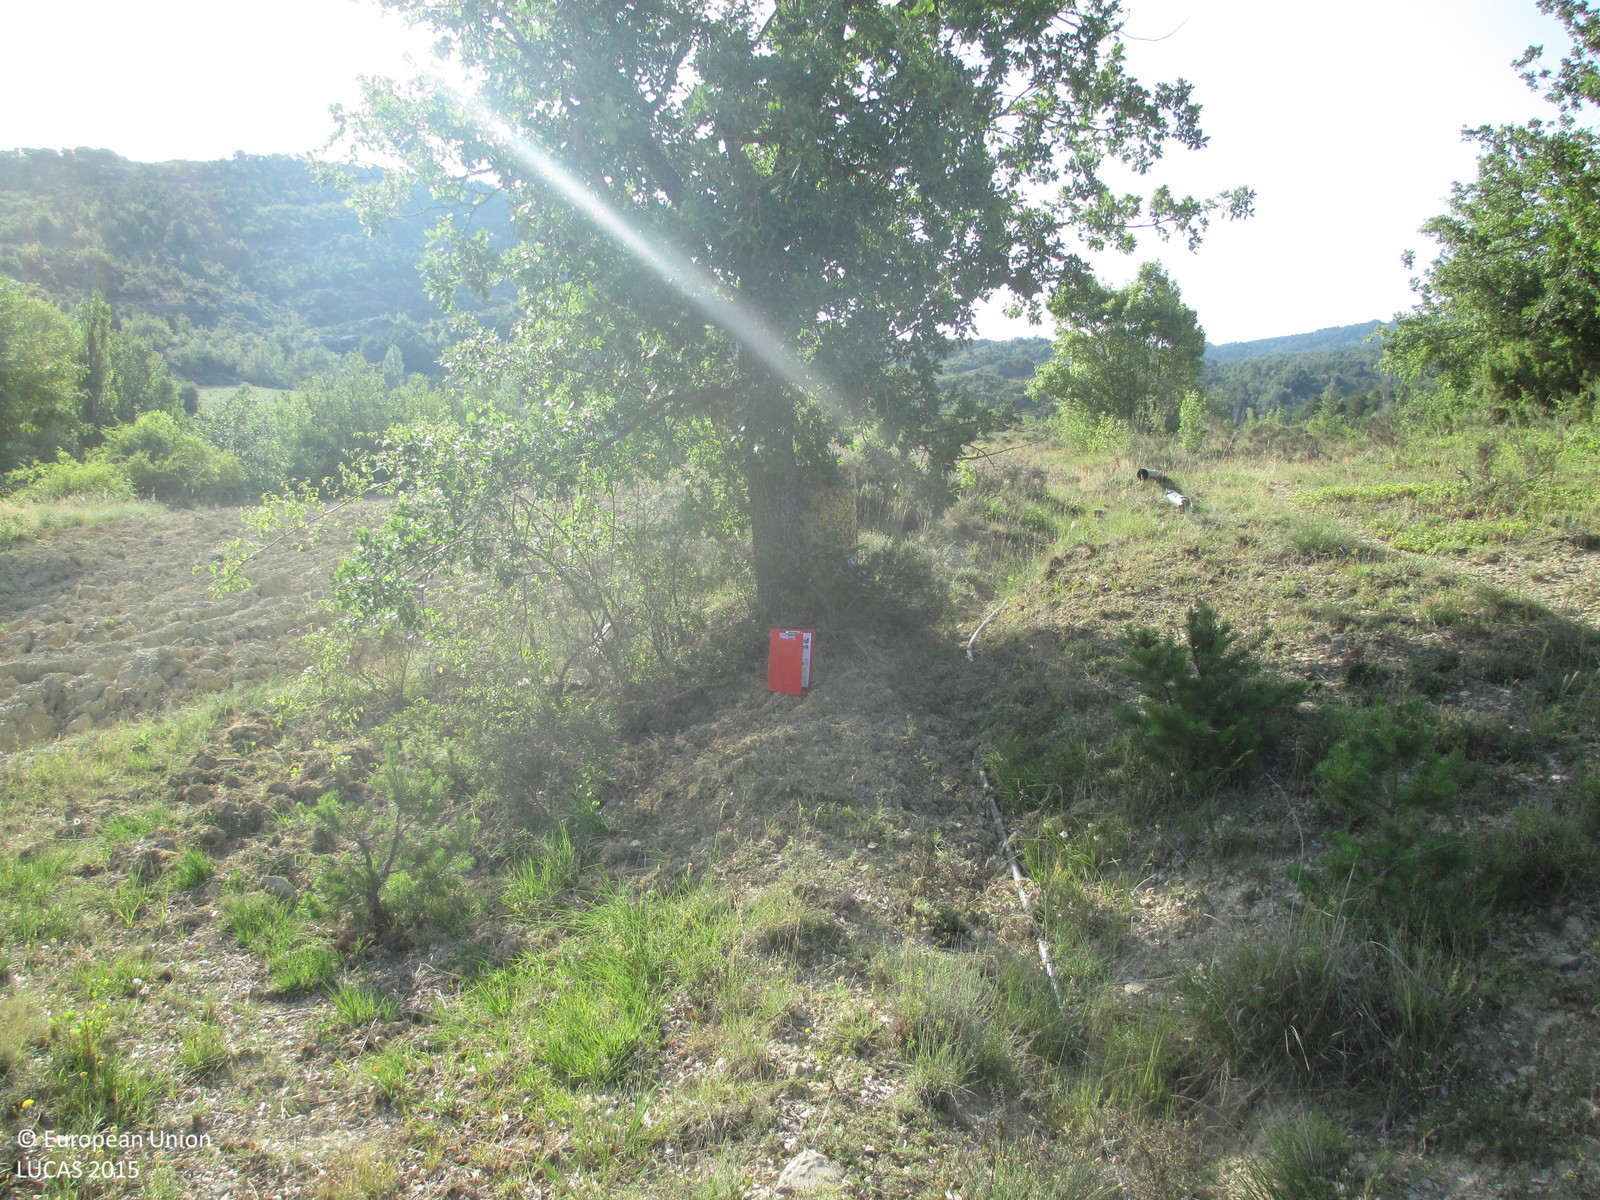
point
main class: Grassland
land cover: Grassland with sparse tree/shrub cover
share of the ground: > 75 %
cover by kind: herbaceous plants 90 %, broadleaved forest trees 5 %, shrubs 5 %
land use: Semi-natural and natural areas not in use
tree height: > 5 m
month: July
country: ES
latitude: 42.3762
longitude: -0.3592
